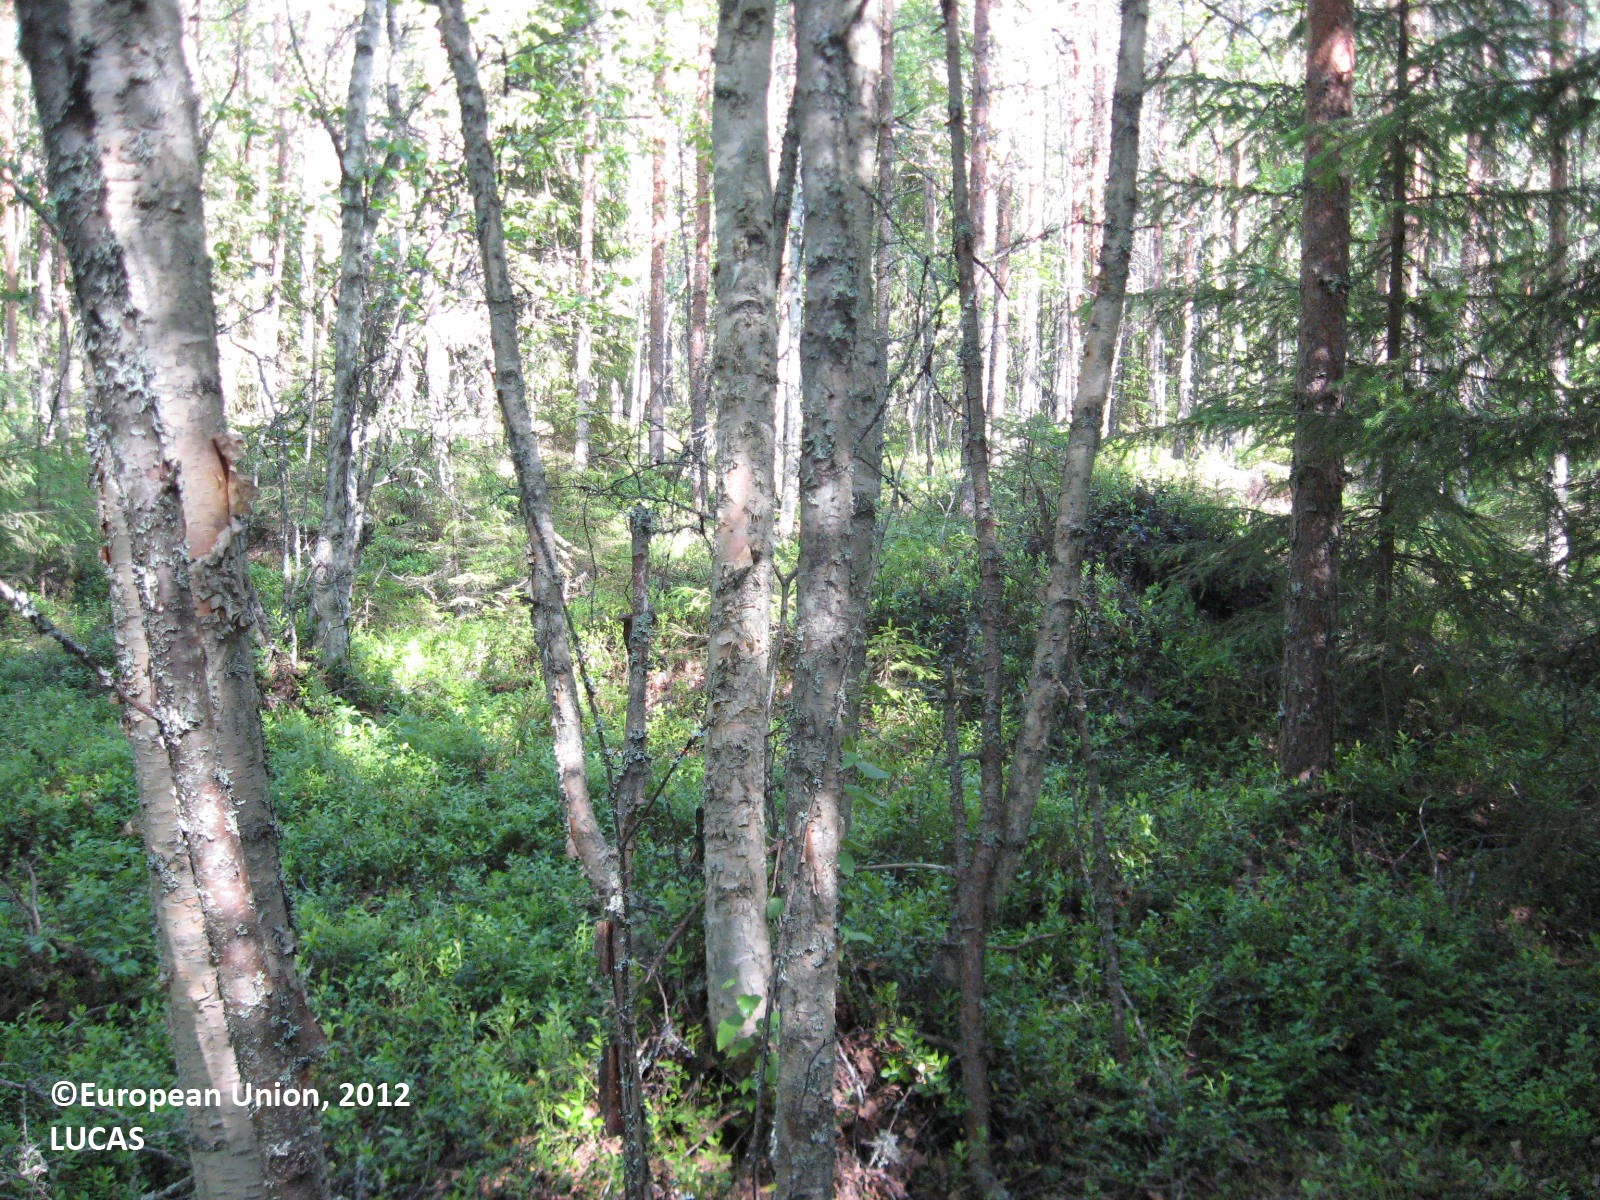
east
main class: Woodland
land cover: Other mixed woodland
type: boreal forest
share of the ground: > 75 %
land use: Forestry
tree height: > 5 m
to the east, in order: Other mixed woodland; Ditches and canals; Pine dominated coniferous woodland; Spruce dominated coniferous woodland; Shruby margins; Ditches and canals; Grass margins; Paved roads, cycling and walking lanes; Grass margins; Ditches and canals; Shruby margins; Pine dominated coniferous woodland; Spruce dominated coniferous woodland
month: June
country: FI
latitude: 62.6779
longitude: 21.7821
